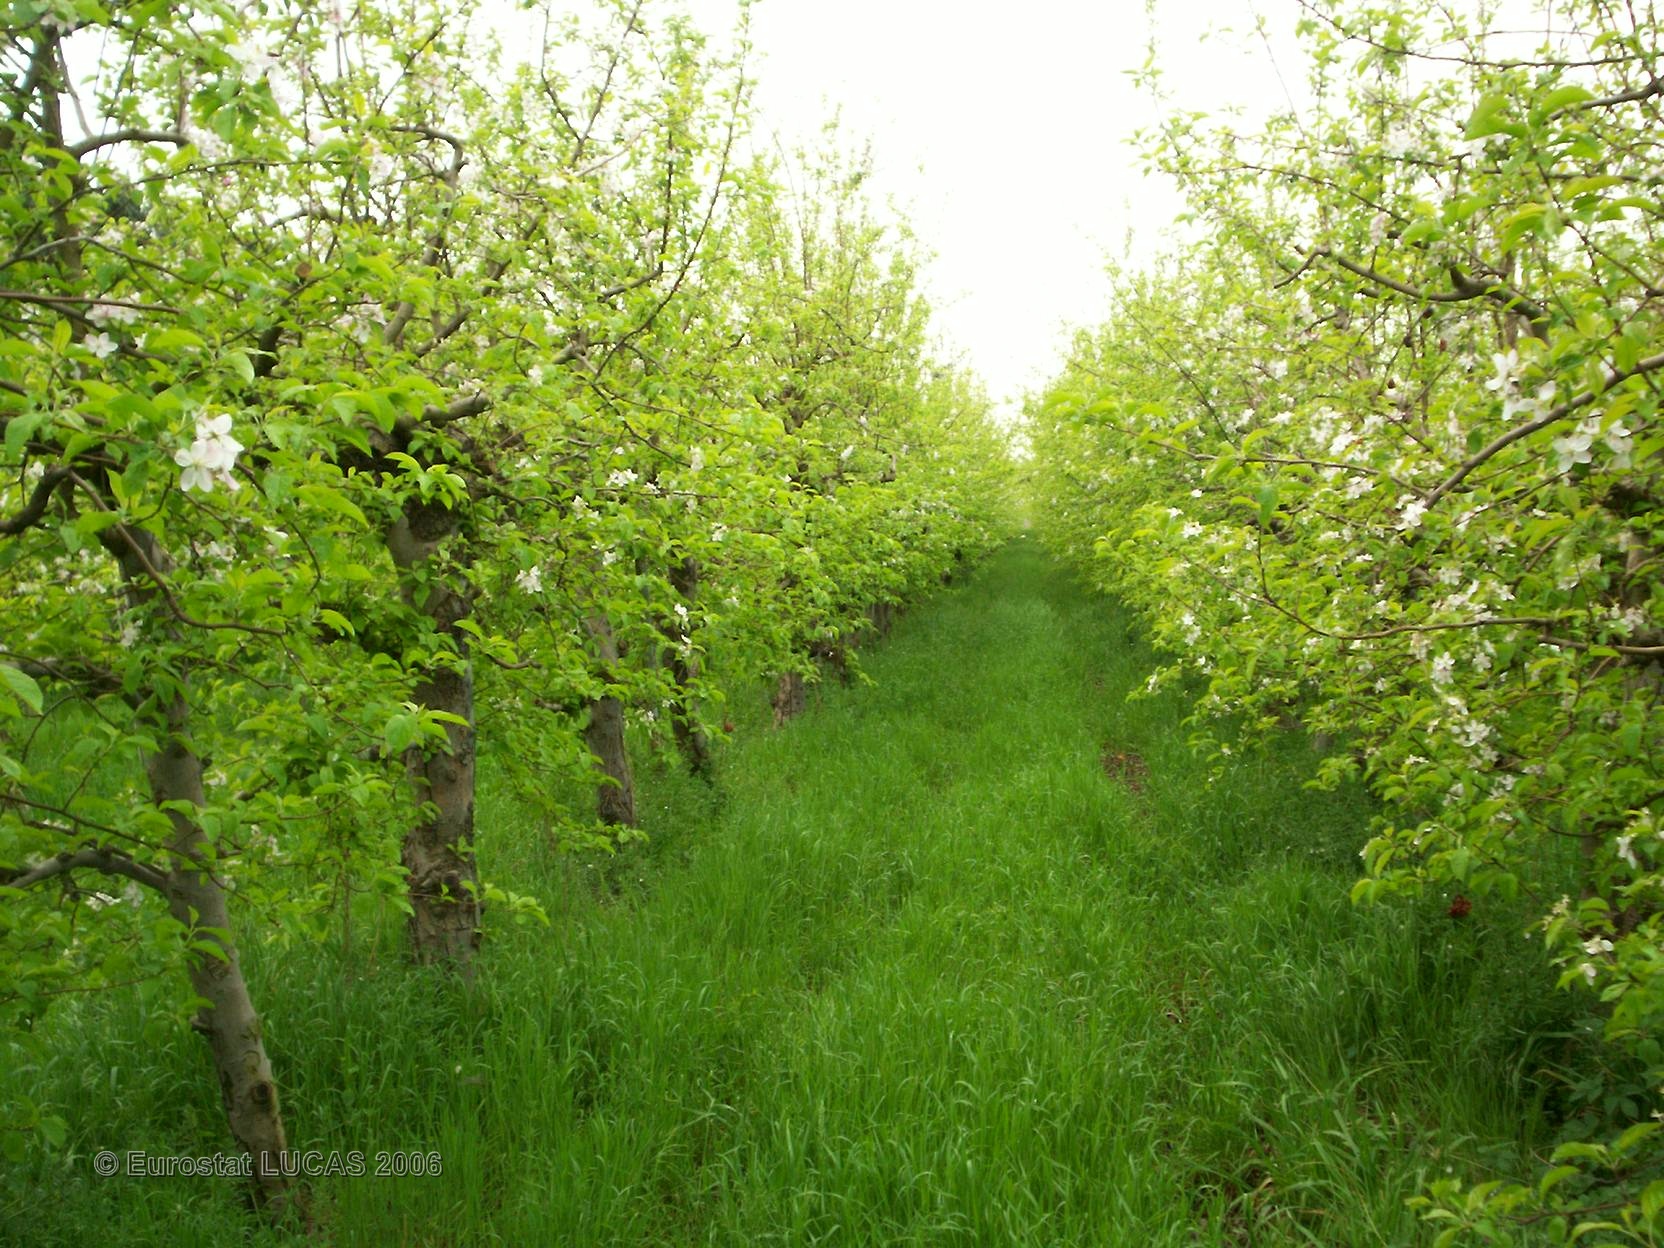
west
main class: Cropland
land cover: Apple fruit
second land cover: Grassland with sparse tree/shrub cover
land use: Agriculture (excluding fallow land and kitchen gardens)
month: April
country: FR
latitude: 43.8095
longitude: 4.8998
